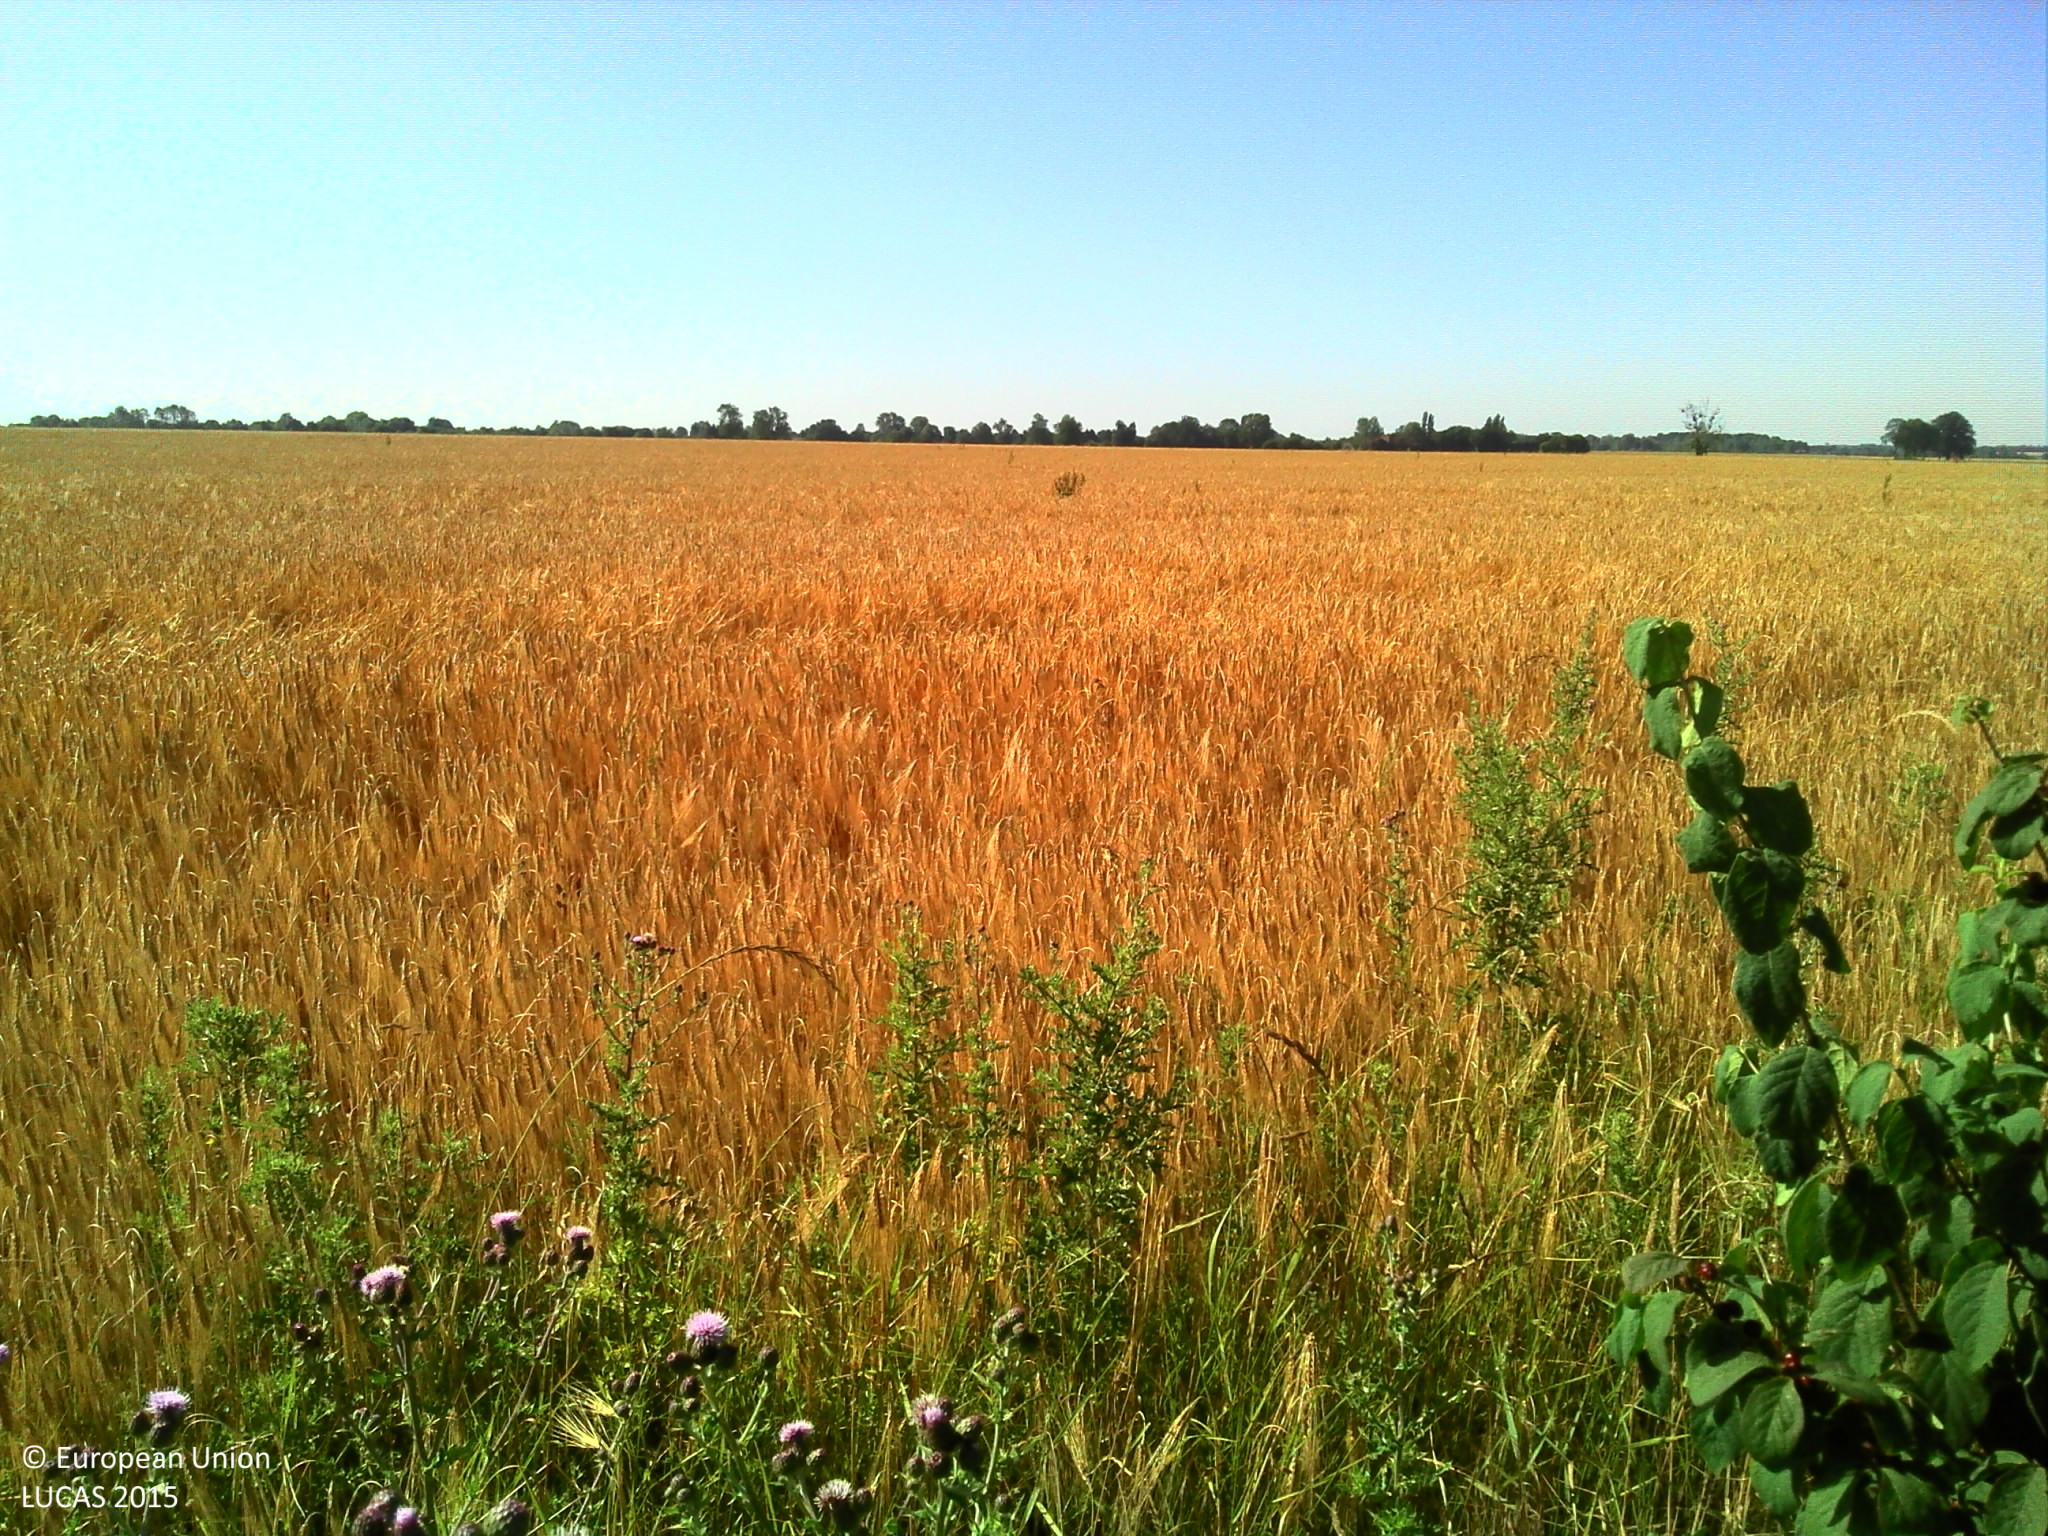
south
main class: Cropland
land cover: Maize
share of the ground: > 75 %
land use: Agriculture (excluding fallow land and kitchen gardens)
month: July
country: FR
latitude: 48.9677
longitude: 0.4527
